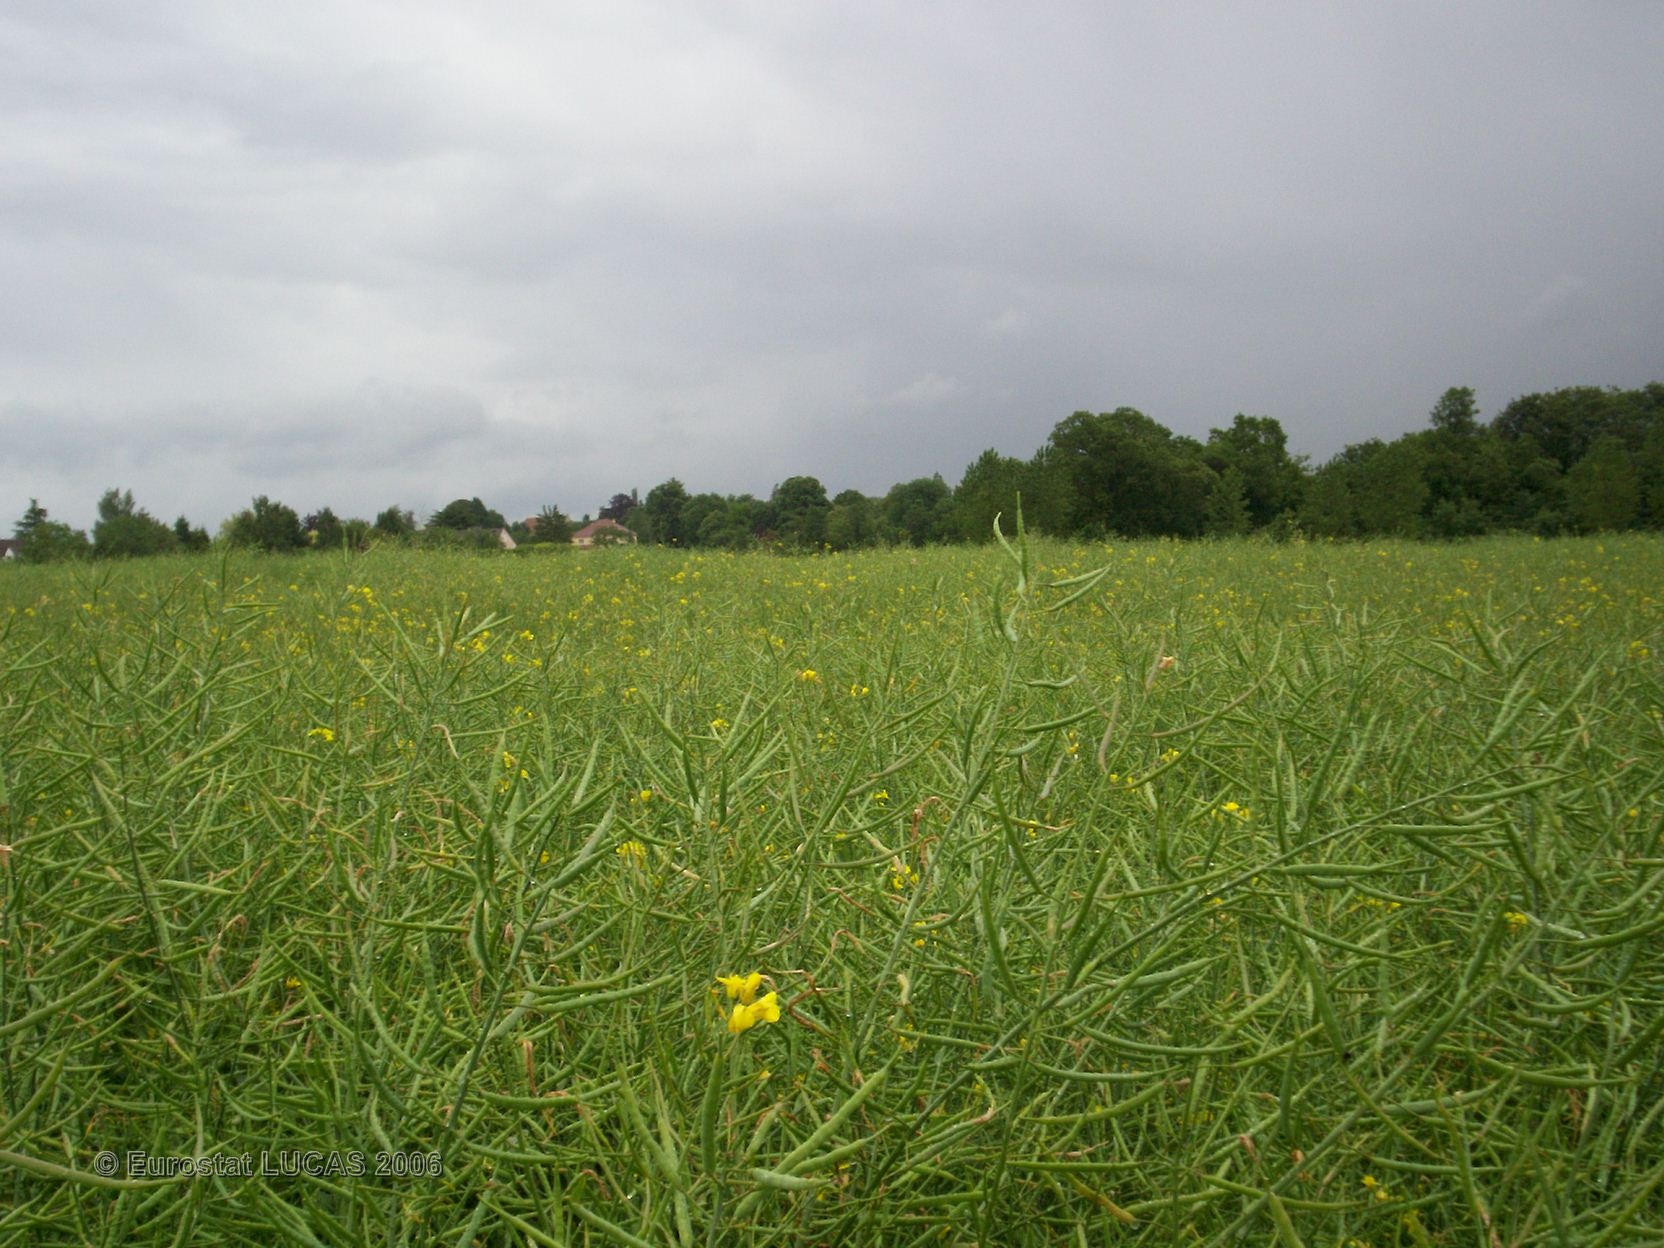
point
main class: Cropland
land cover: Rape and turnip rape
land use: Agriculture (excluding fallow land and kitchen gardens)
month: May
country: FR
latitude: 48.8948
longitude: 2.8568
